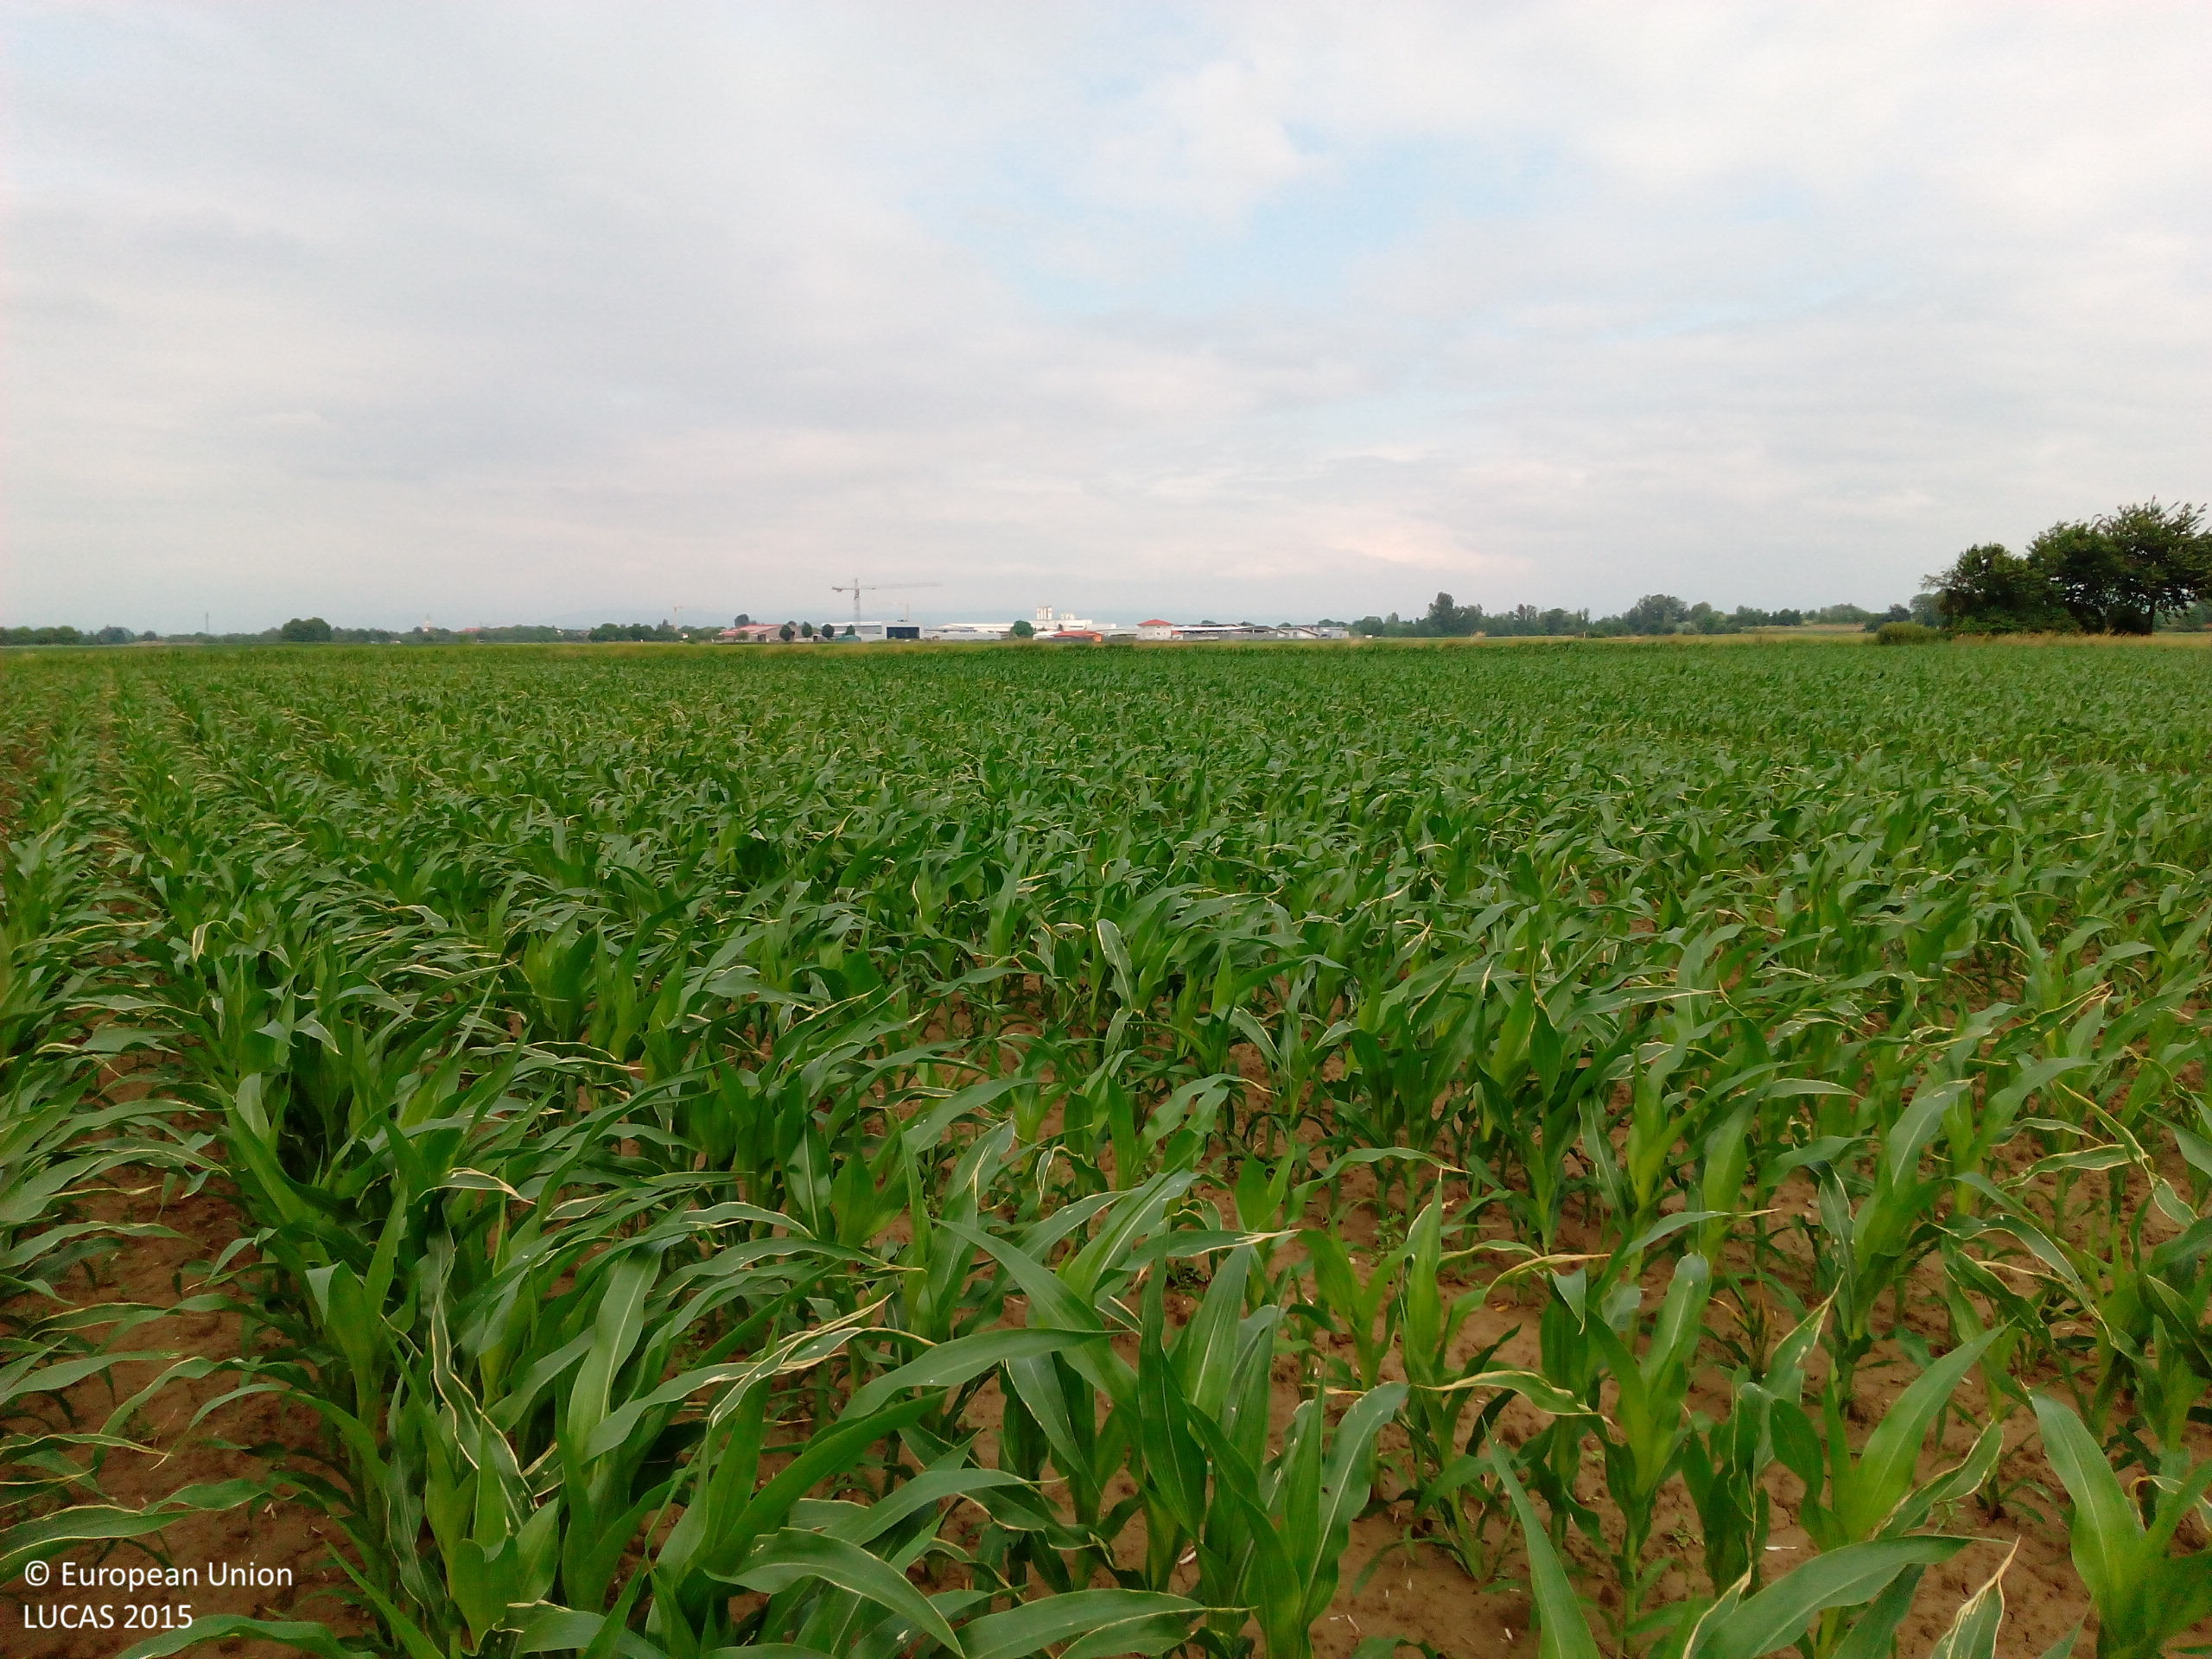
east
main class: Cropland
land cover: Maize
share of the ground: > 75 %
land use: Agriculture (excluding fallow land and kitchen gardens)
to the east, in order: Maize; Grass margins; Paved roads, cycling and walking lanes; Barley
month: June
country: DE
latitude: 48.1619
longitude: 7.6214
